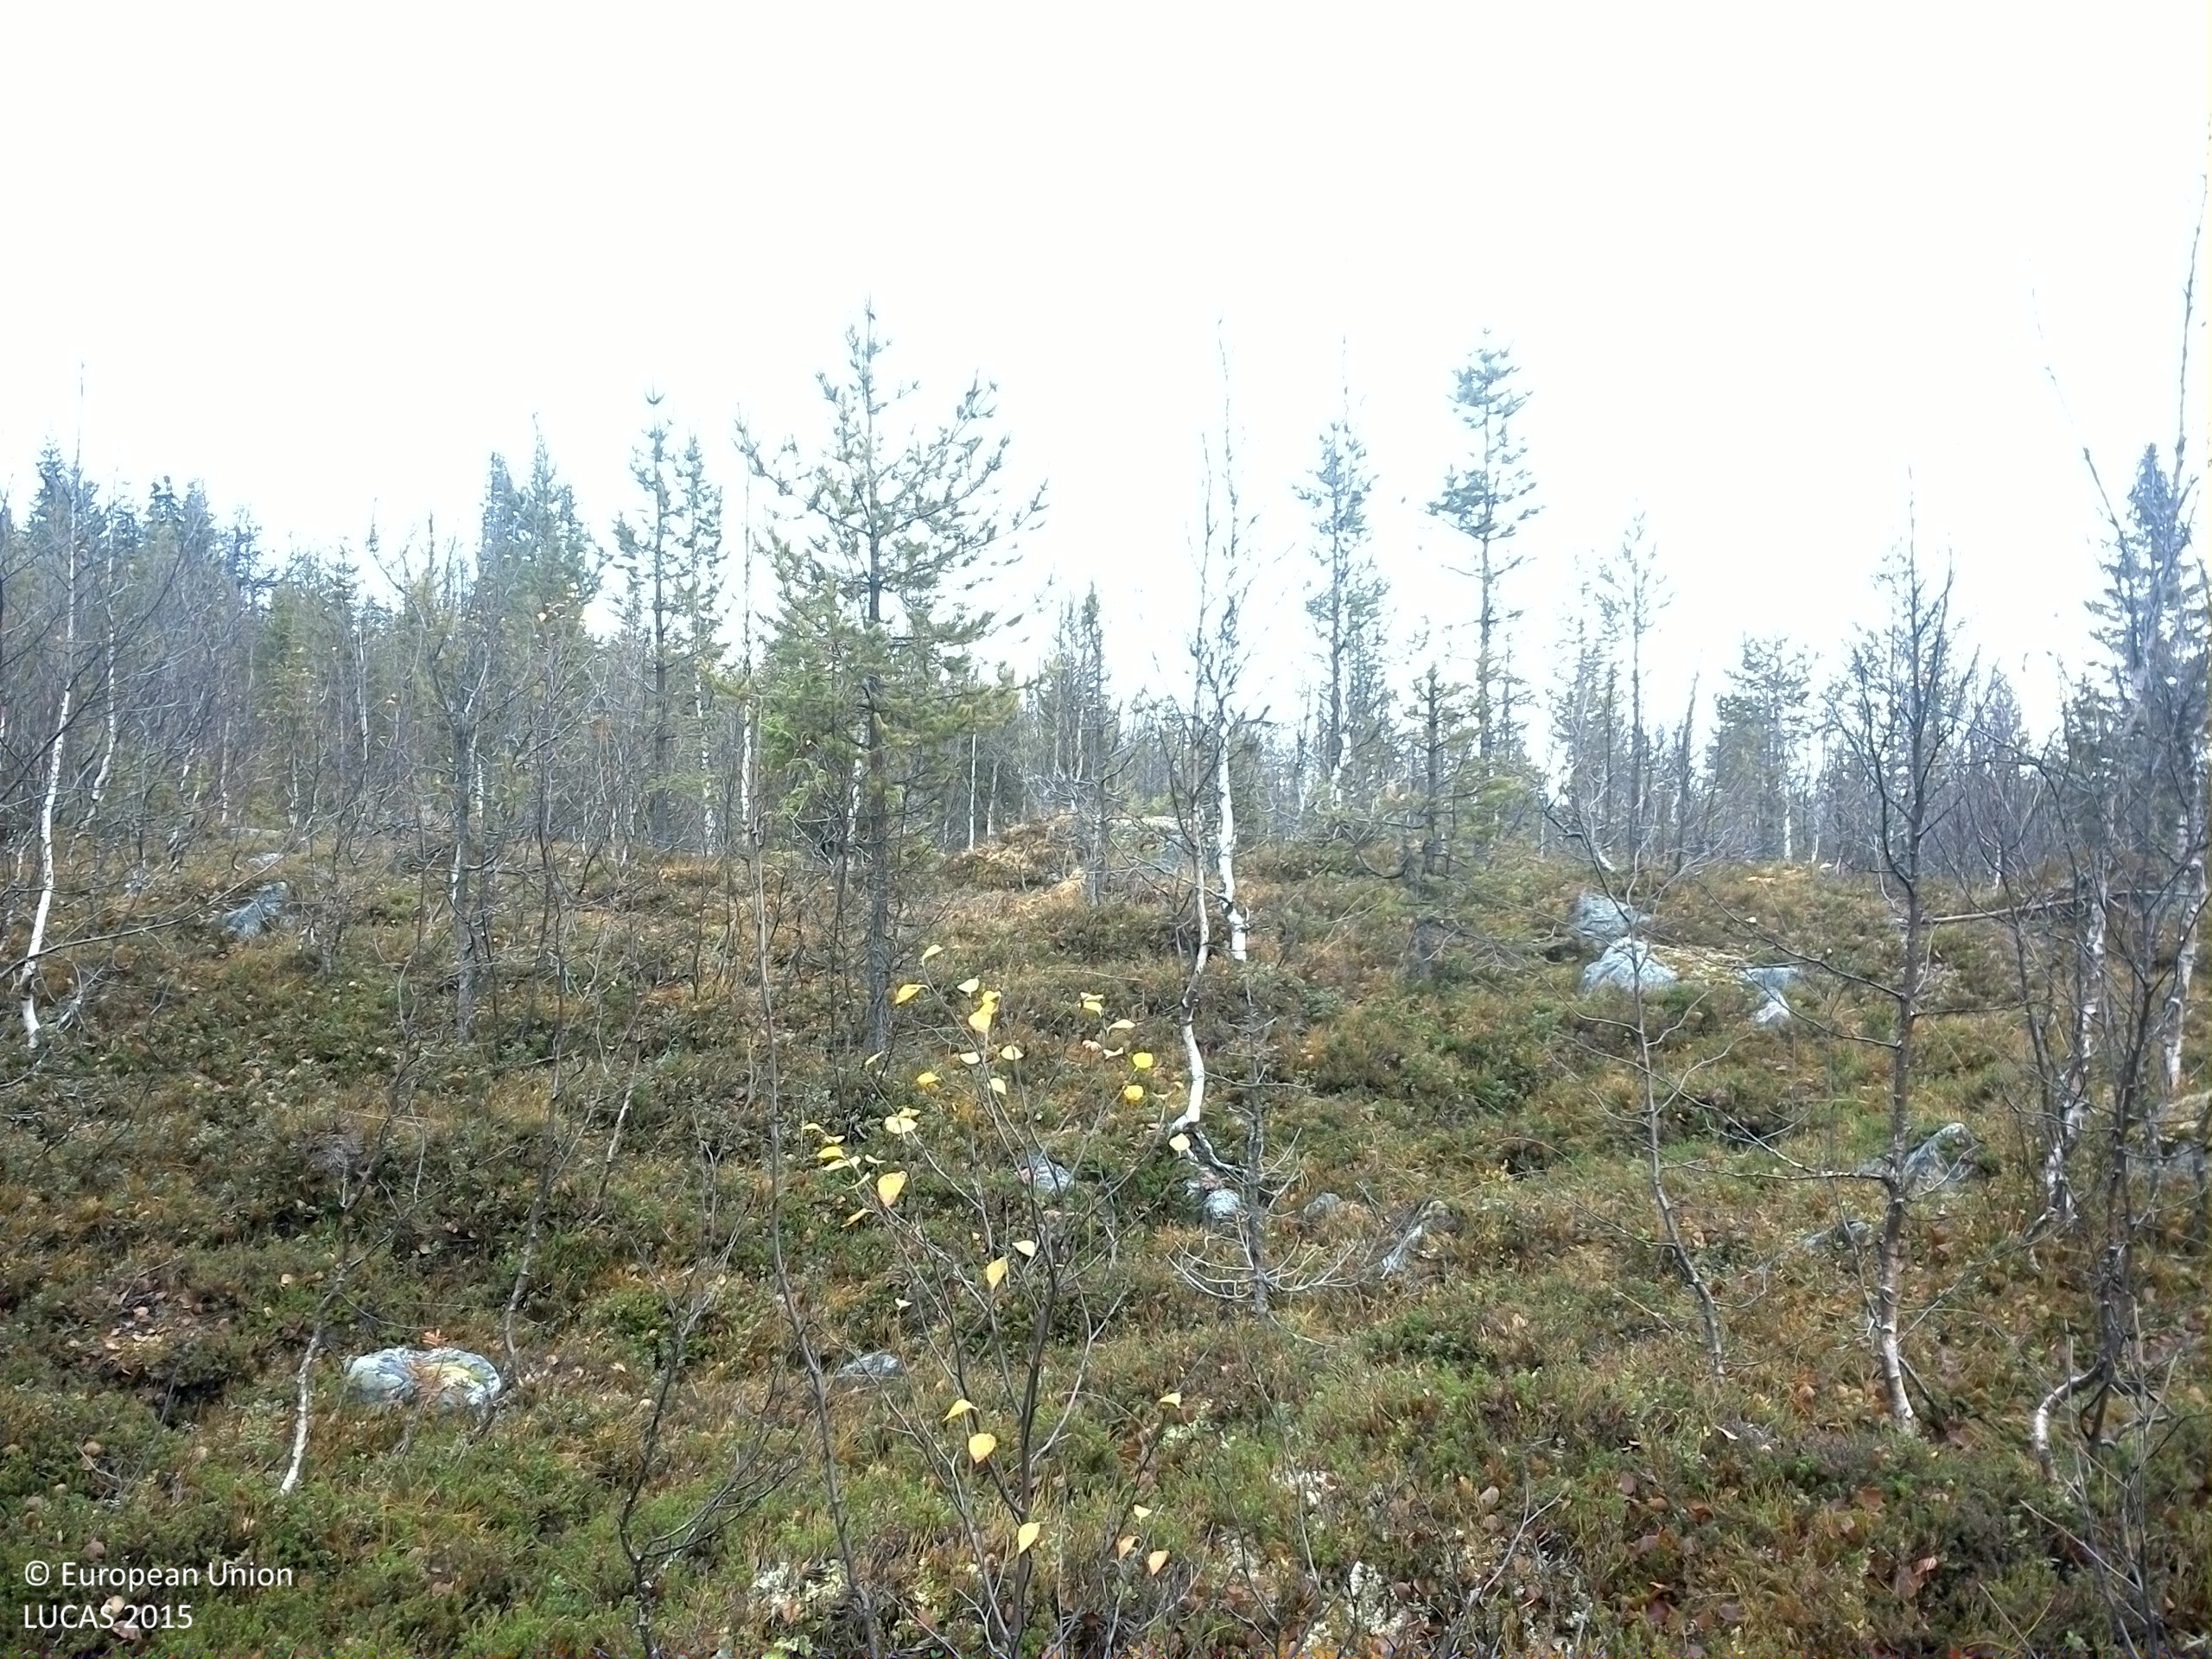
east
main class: Woodland
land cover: Pine dominated mixed woodland
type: boreal forest
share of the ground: 25 - 50 %
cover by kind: broadleaved forest trees 30 %, shrubs 30 %, coniferous forest trees 15 %, lichens and mosses 15 %, consolidated bare surface 10 %
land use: Forestry
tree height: < 5 m
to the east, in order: Pine dominated mixed woodland; Rocks and stones; Pine dominated mixed woodland; Spruce dominated mixed woodland; Spruce dominated coniferous woodland
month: October
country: SE
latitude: 64.4337
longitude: 14.8117
